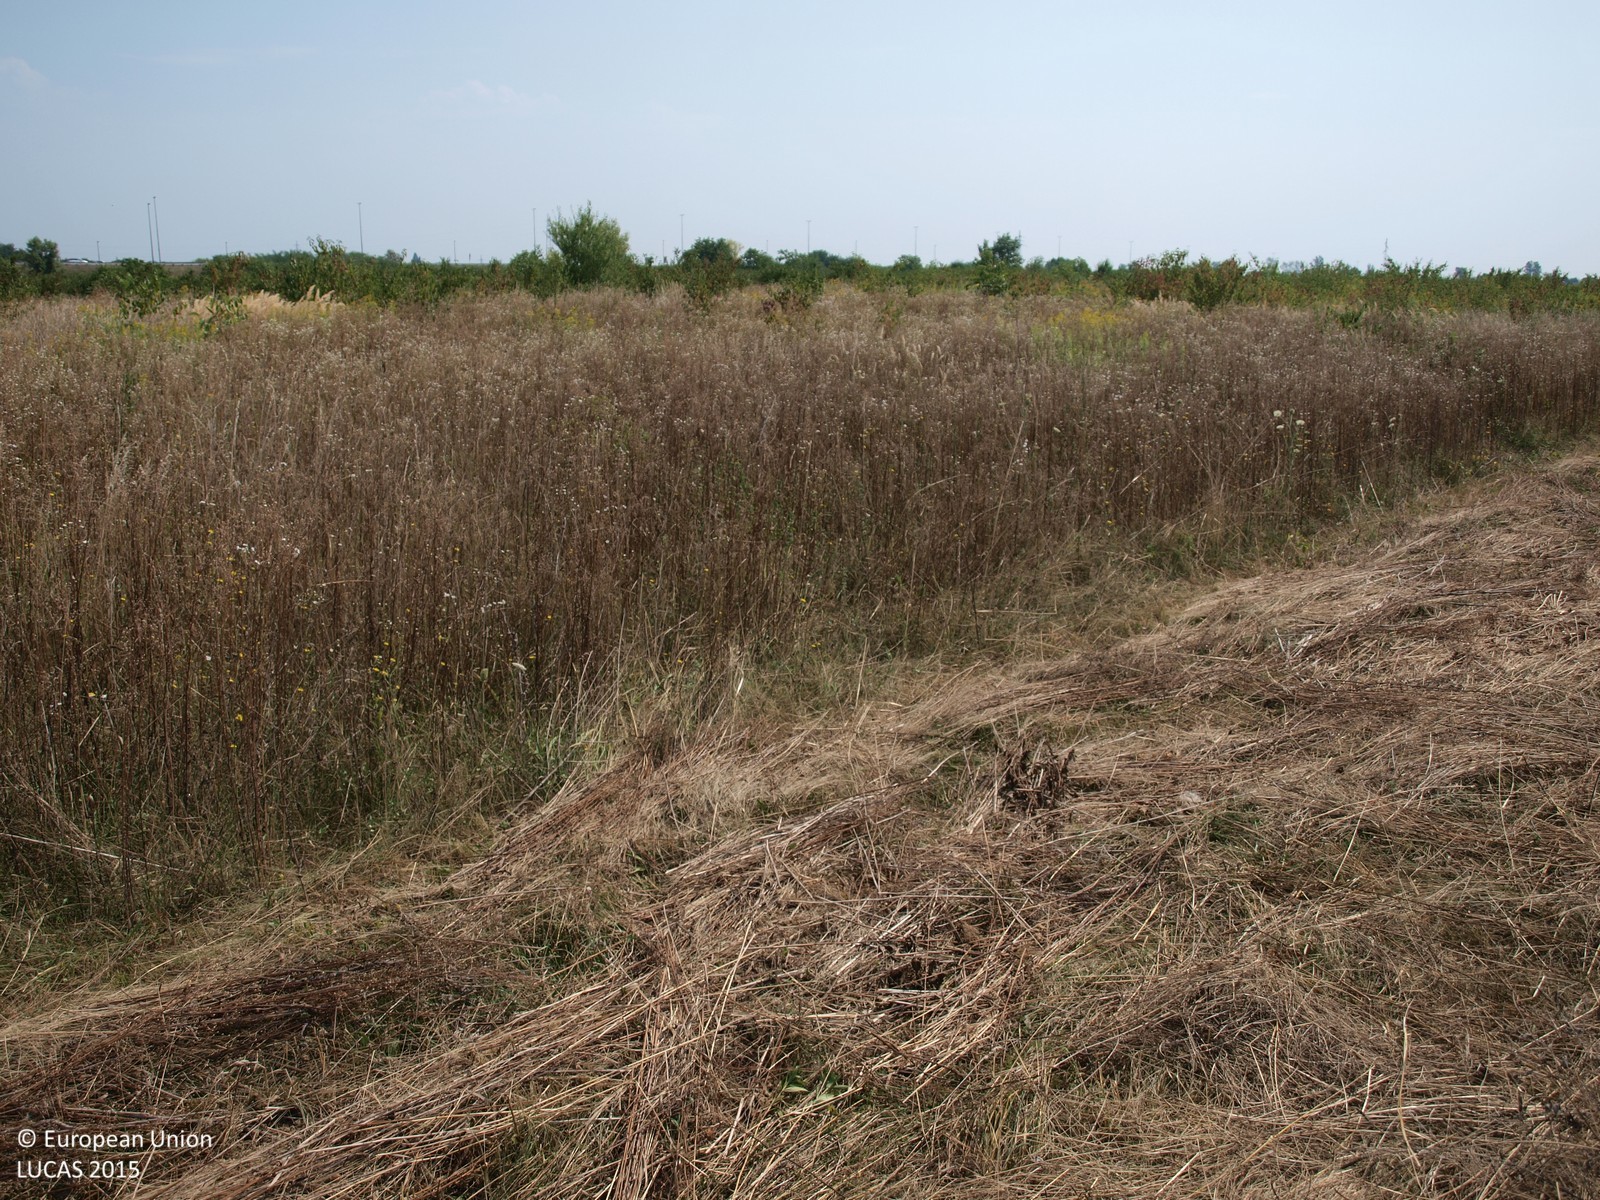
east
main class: Grassland
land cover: Grassland without tree/shrub cover
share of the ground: > 75 %
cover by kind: herbaceous plants 100 %
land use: Agriculture (excluding fallow land and kitchen gardens)
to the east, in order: Grassland without tree/shrub cover; Grassland with sparse tree/shrub cover; Shrubland with sparse tree cover
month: August
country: HR
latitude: 45.7550
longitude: 15.8984
